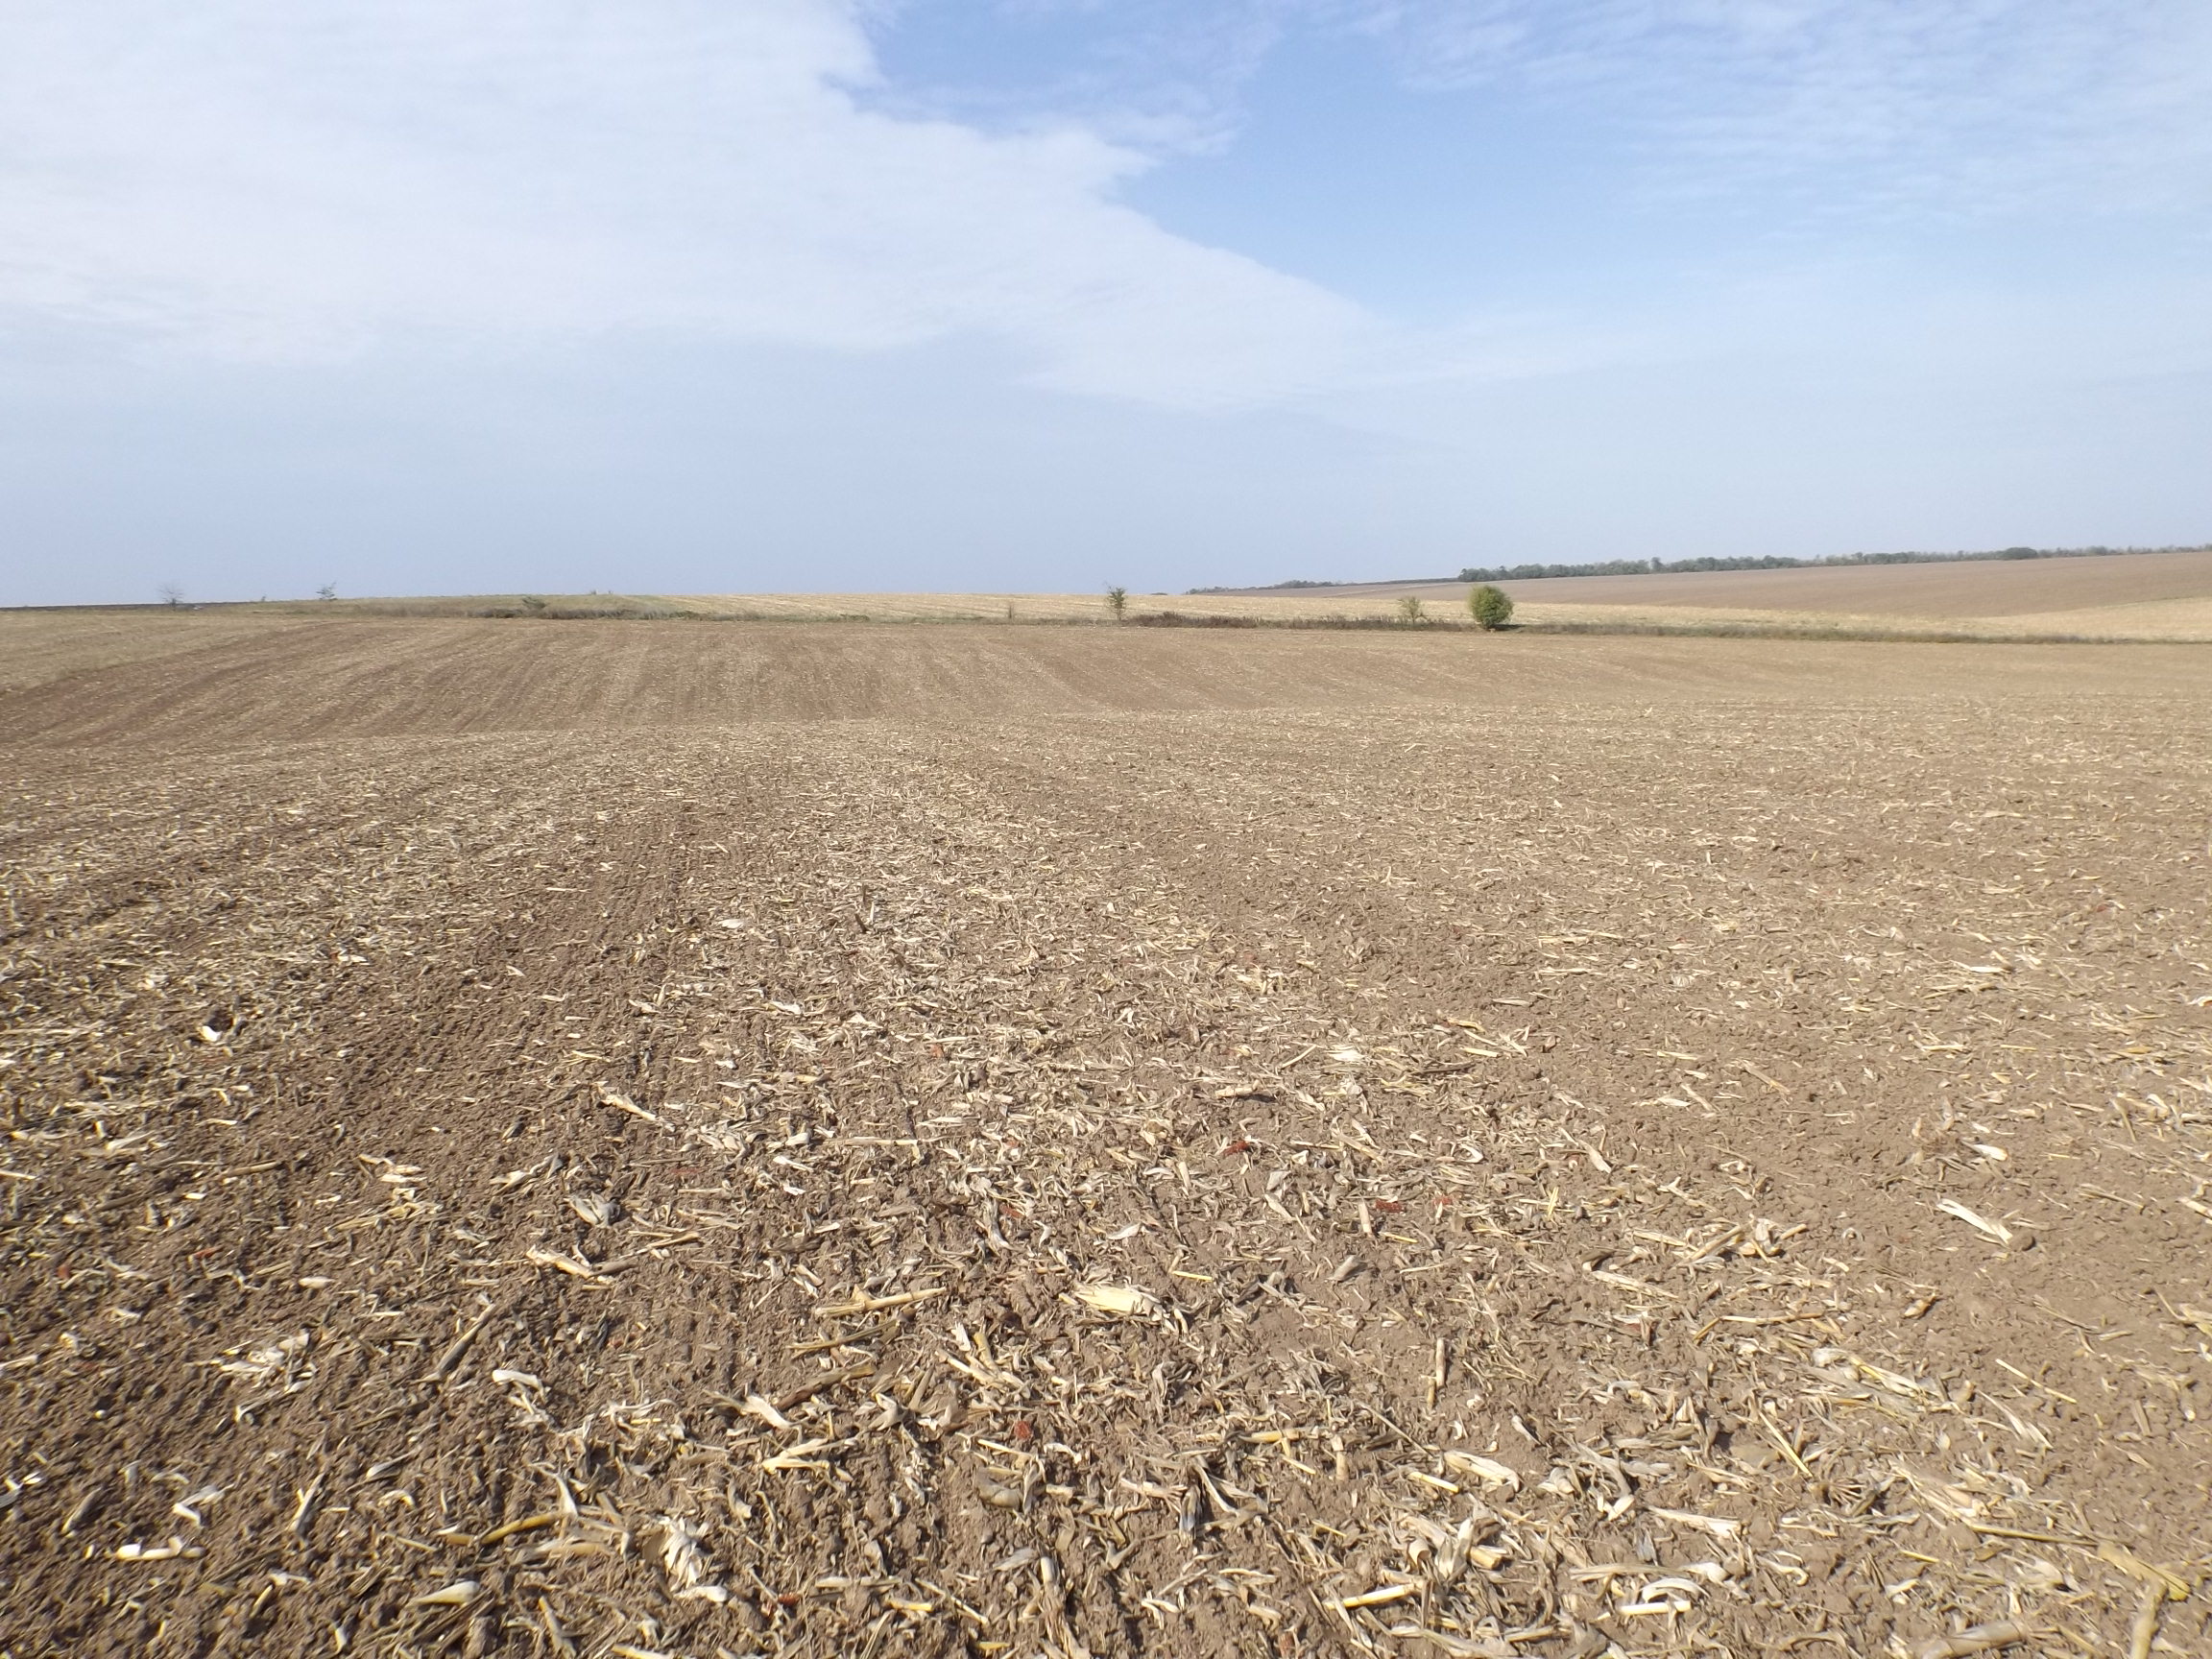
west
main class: Cropland
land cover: Maize
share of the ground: < 10 %
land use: Agriculture (excluding fallow land and kitchen gardens)
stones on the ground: < 10 %
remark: Harvested field
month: October
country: BG
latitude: 43.9276
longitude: 26.8976
